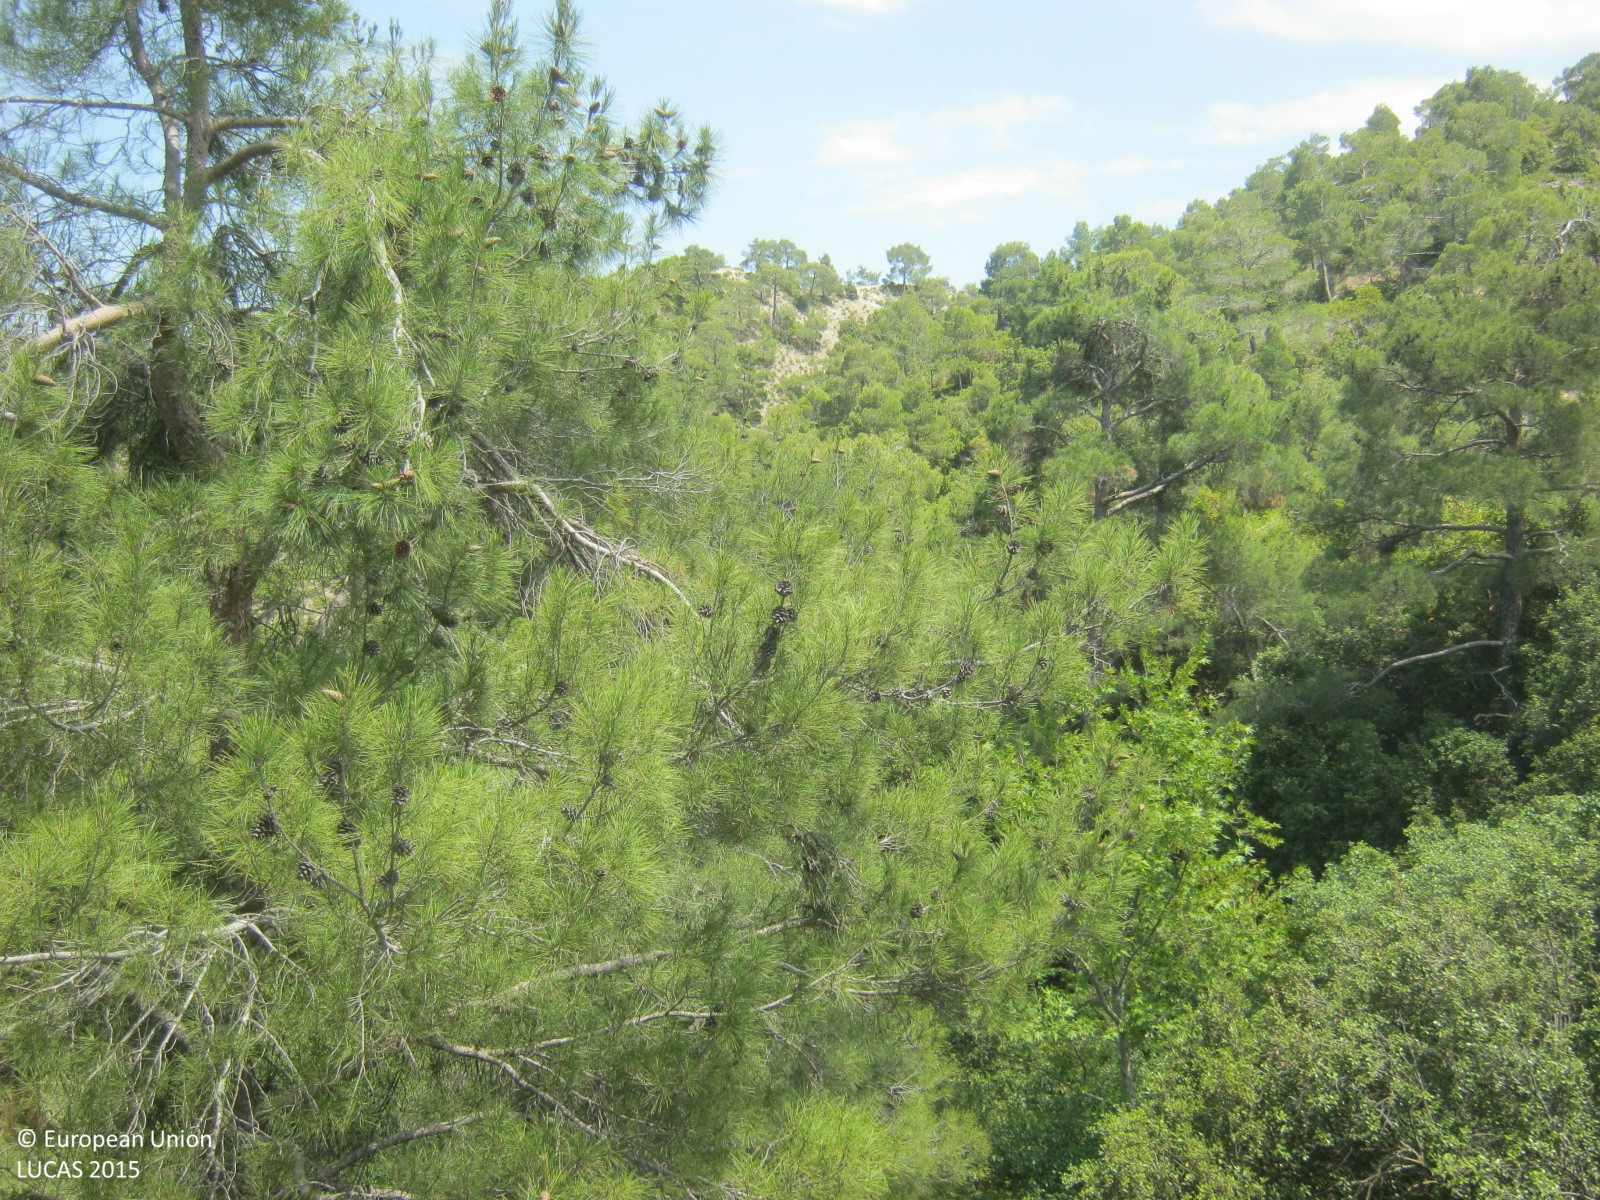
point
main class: Woodland
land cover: Pine dominated coniferous woodland
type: coniferous forest of the mediterranean region
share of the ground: > 75 %
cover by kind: coniferous forest trees 80 %, shrubs 10 %, broadleaved forest trees 5 %, unconsolidated bare surface 5 %
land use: Forestry
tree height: > 5 m
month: June
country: CY
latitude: 34.9985
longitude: 32.8594
